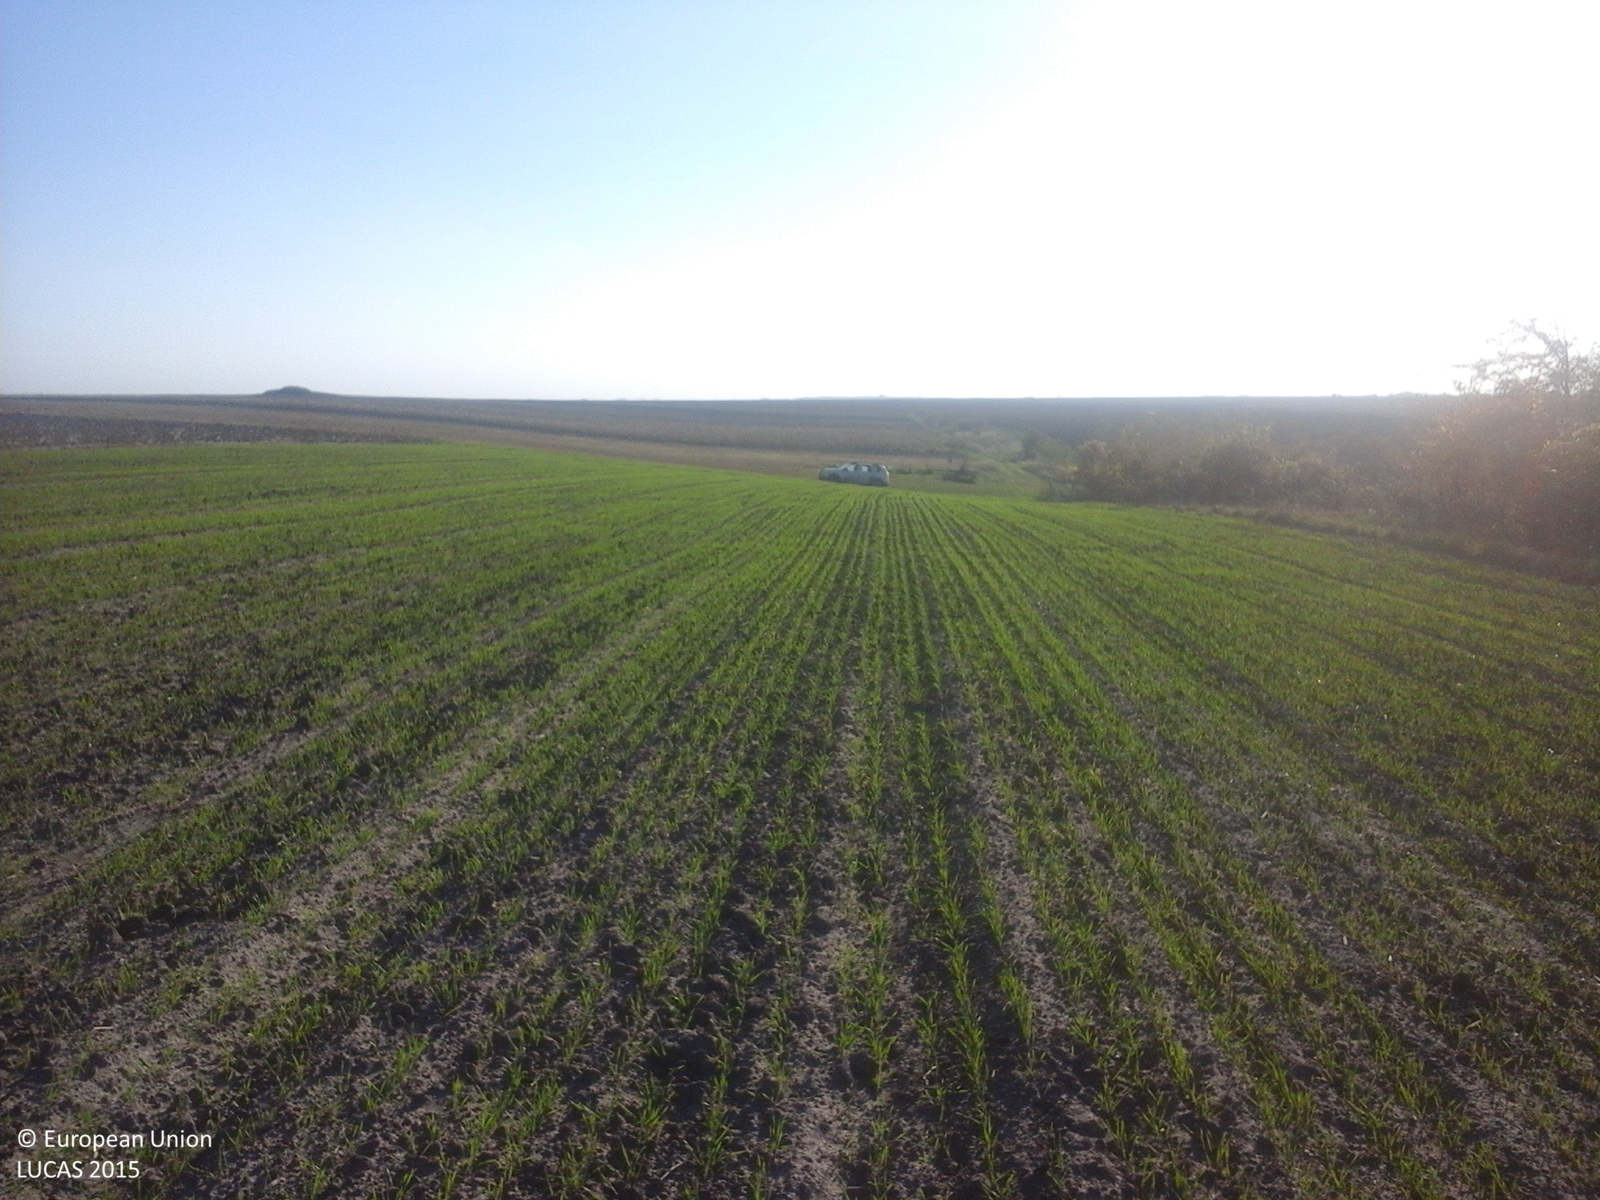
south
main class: Cropland
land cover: Common wheat
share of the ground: 10 - 25 %
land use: Agriculture (excluding fallow land and kitchen gardens)
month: October
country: RO
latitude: 45.2706
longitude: 27.3409
